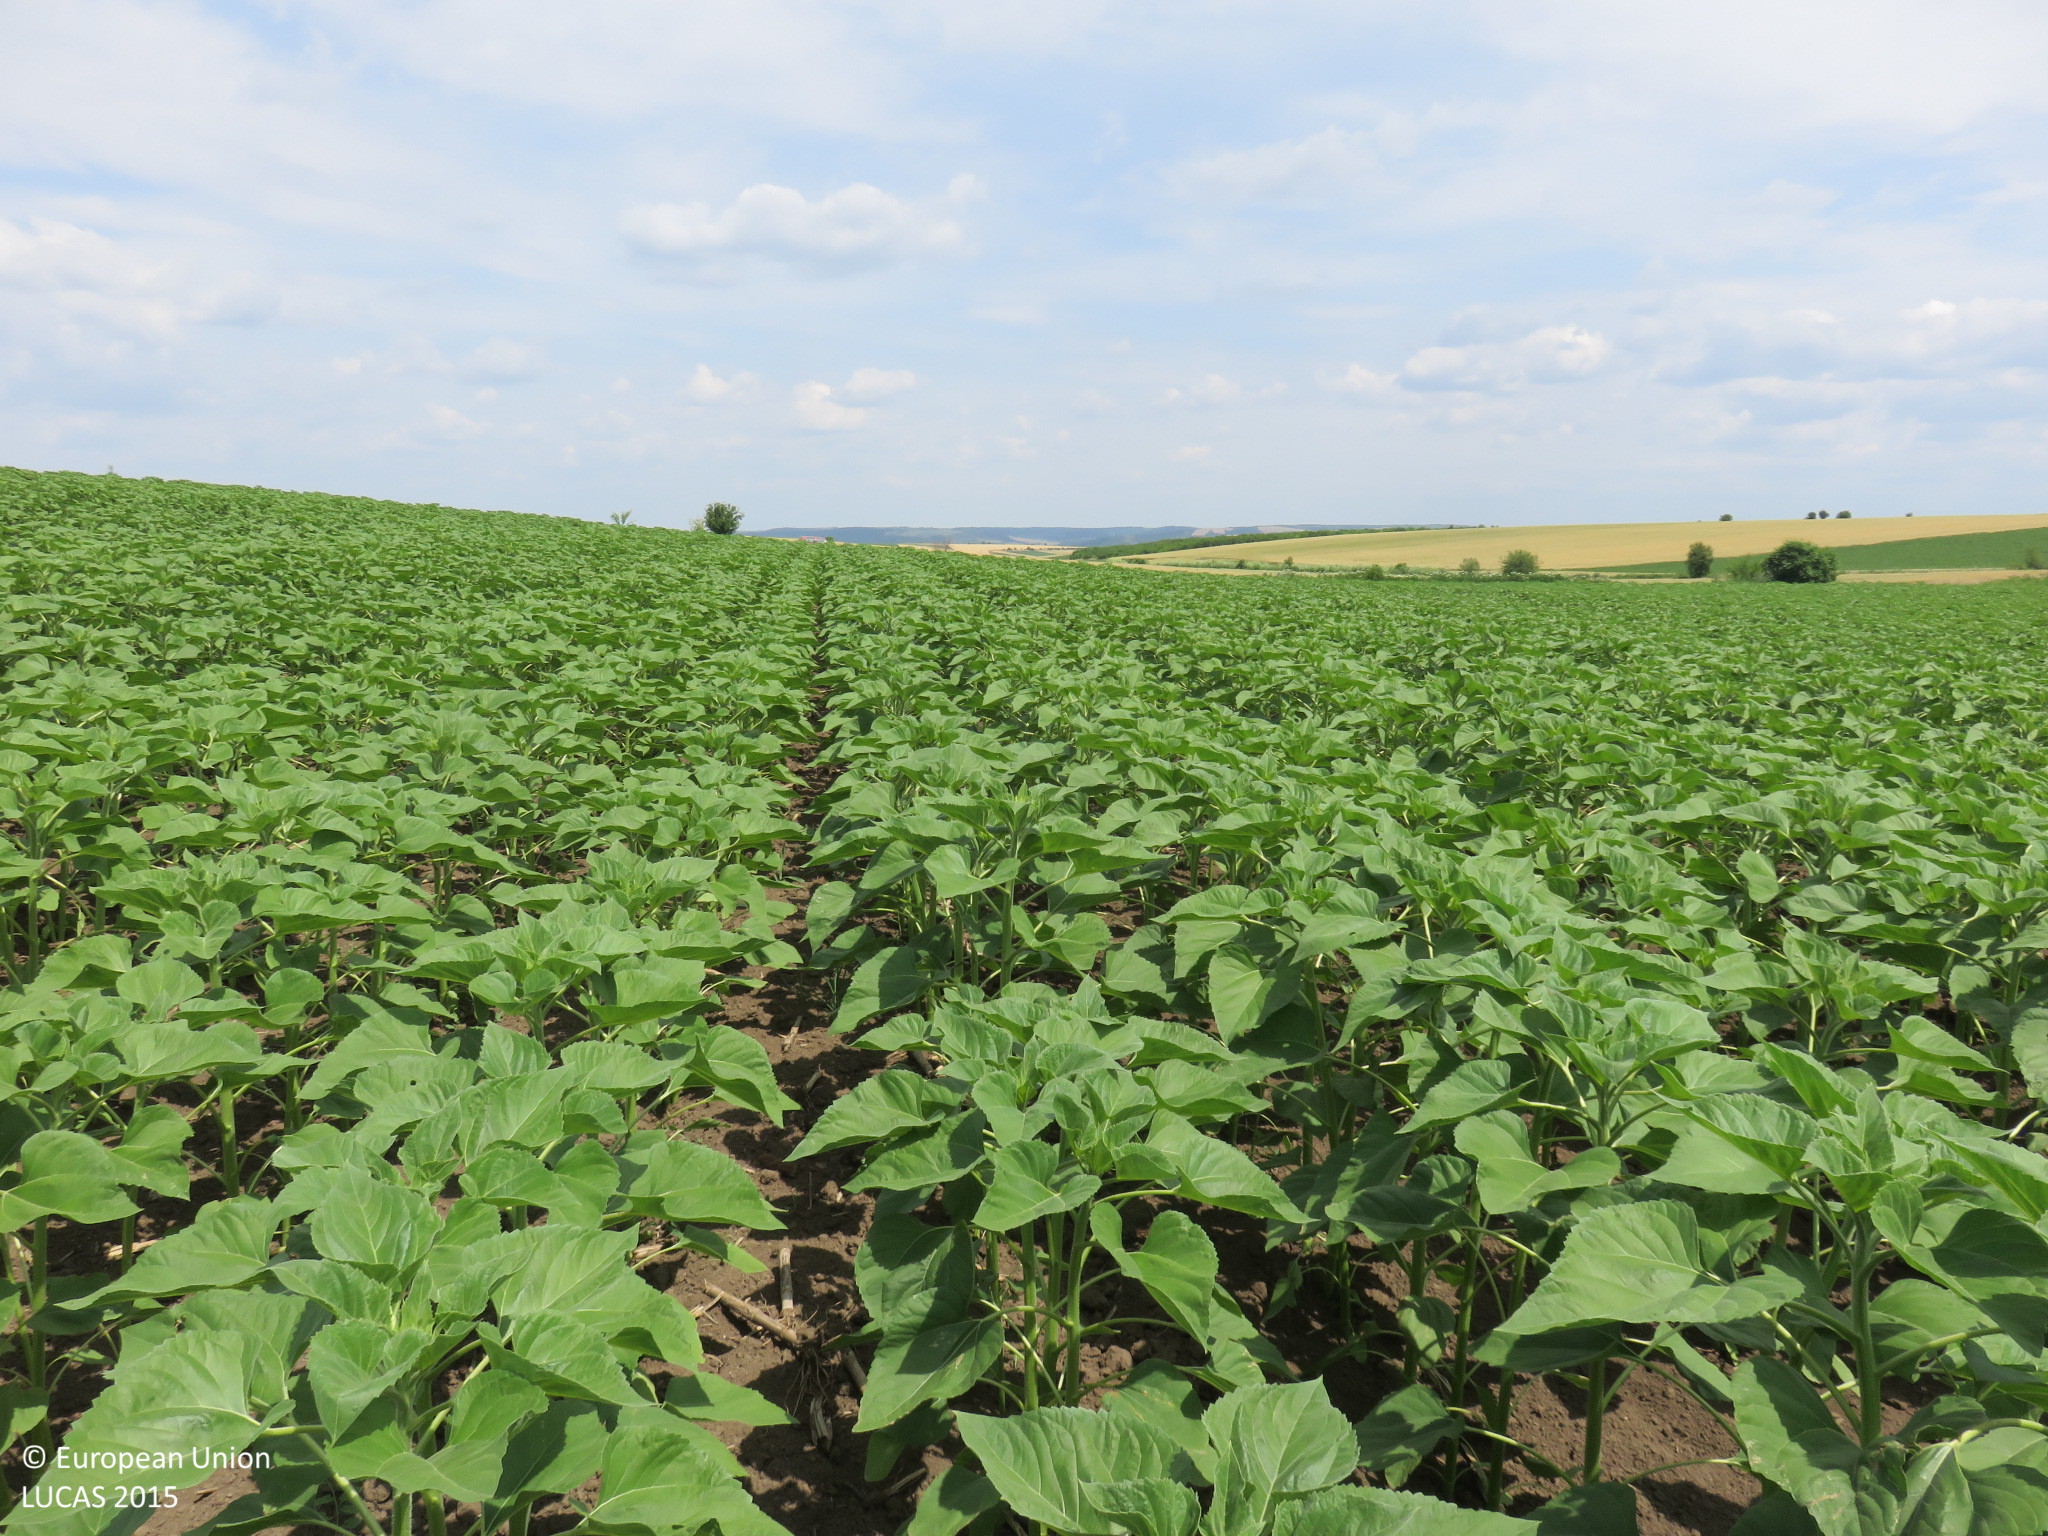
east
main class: Cropland
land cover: Sunflower
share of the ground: > 75 %
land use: Agriculture (excluding fallow land and kitchen gardens)
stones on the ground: < 10 %
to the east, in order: Sunflower; Grassland with sparse tree/shrub cover; Tracks; Grass margins; Common wheat
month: June
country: BG
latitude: 43.4951
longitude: 24.4679
